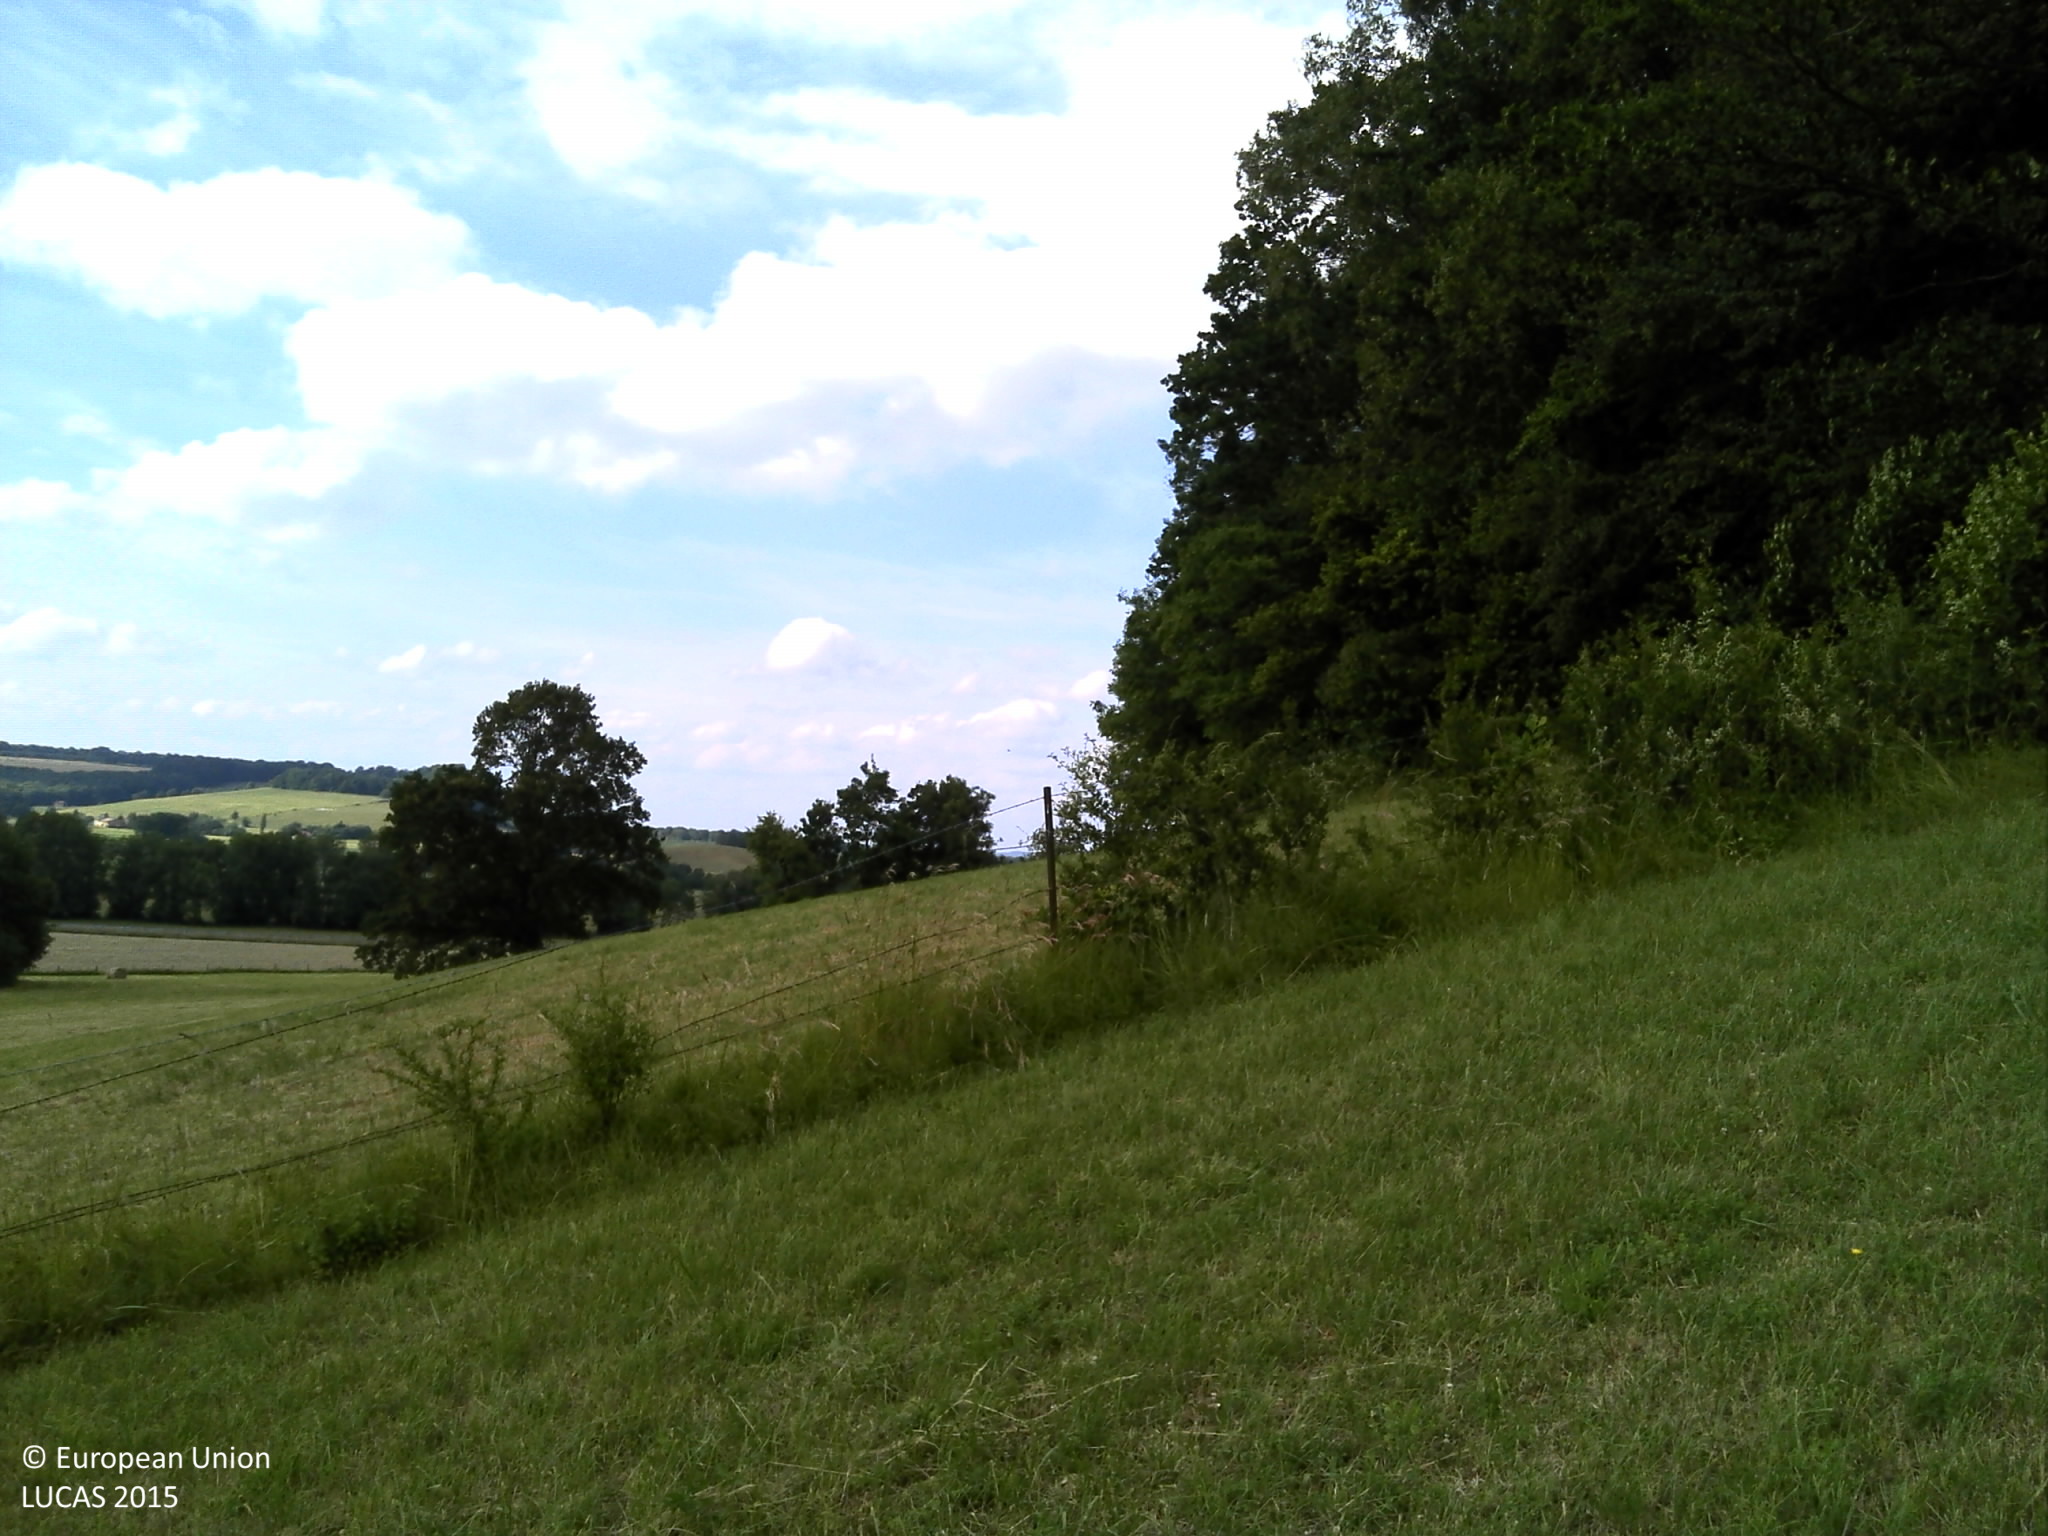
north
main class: Grassland
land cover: Grassland without tree/shrub cover
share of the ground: > 75 %
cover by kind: herbaceous plants 100 %
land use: Agriculture (excluding fallow land and kitchen gardens)
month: June
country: FR
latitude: 49.4472
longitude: 5.0736
